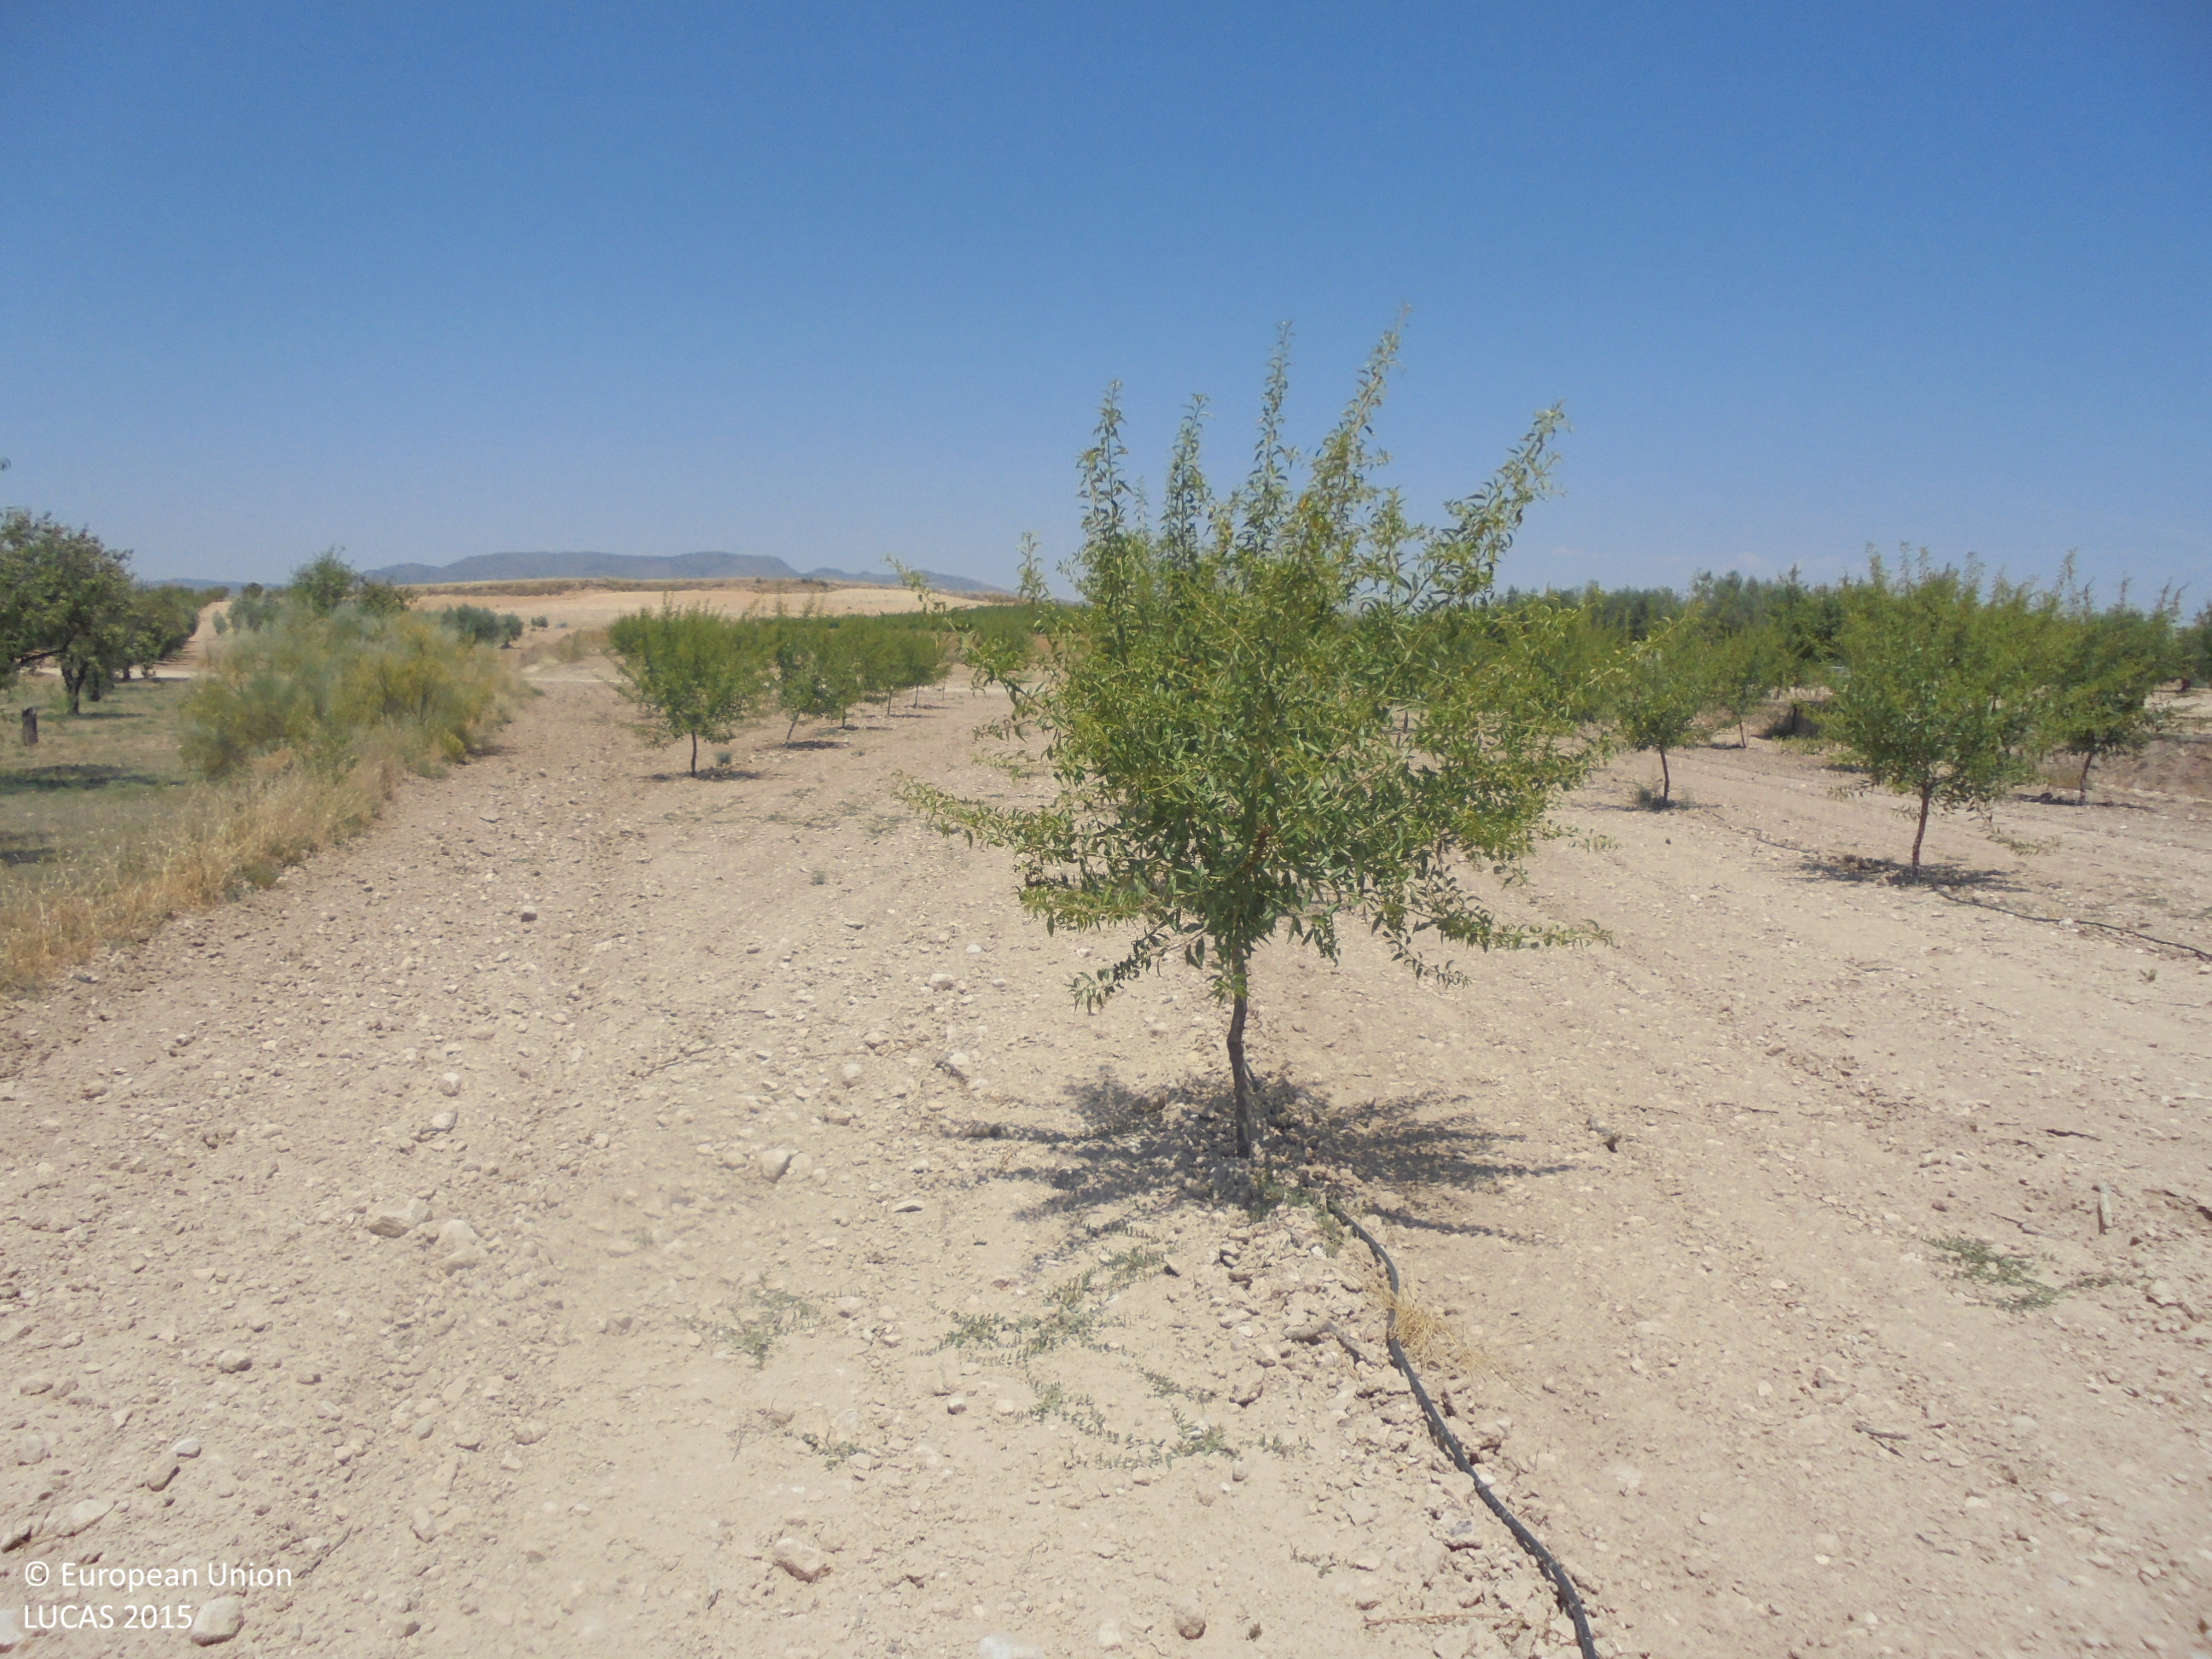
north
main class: Cropland
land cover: Nuts trees
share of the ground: 10 - 25 %
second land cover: Other bare soil
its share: > 75 %
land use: Agriculture (excluding fallow land and kitchen gardens)
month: July
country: ES
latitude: 38.5652
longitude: -1.5040
